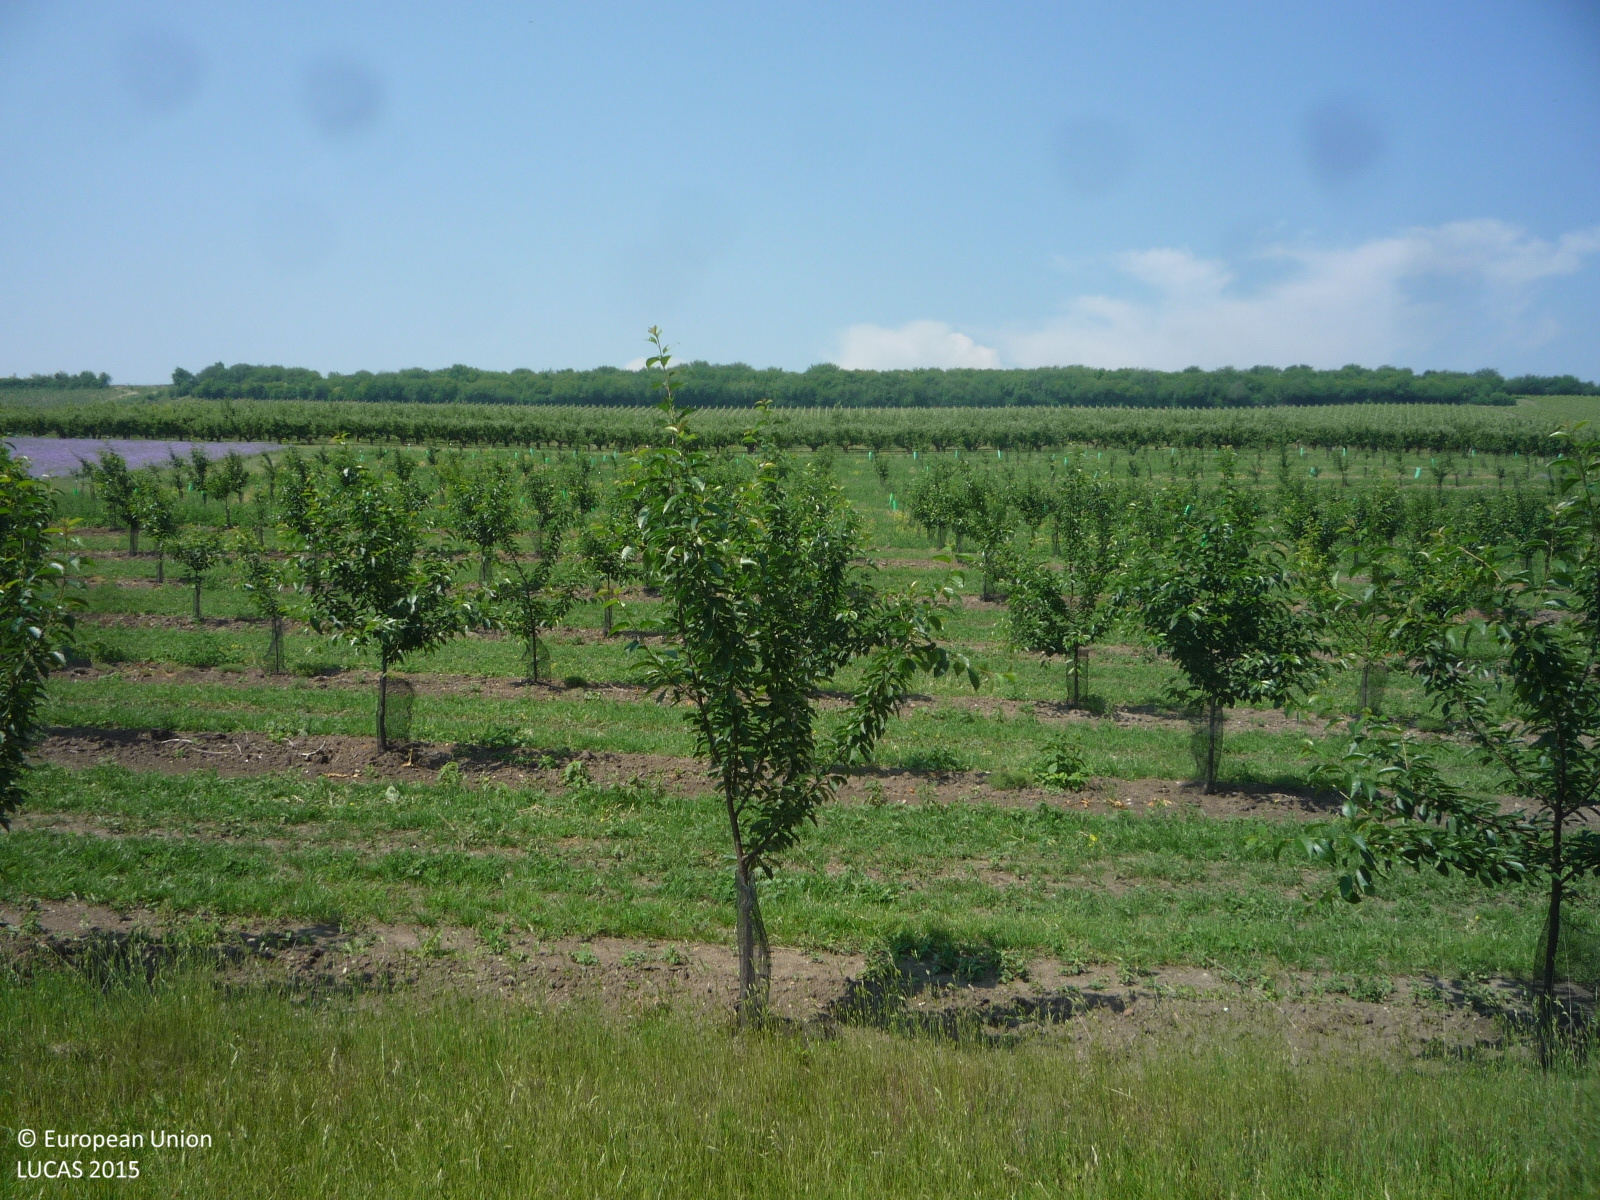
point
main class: Cropland
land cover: Cherry fruit
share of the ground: 25 - 50 %
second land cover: Grassland without tree/shrub cover
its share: > 75 %
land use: Agriculture (excluding fallow land and kitchen gardens)
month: June
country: CZ
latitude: 50.2363
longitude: 14.1090
